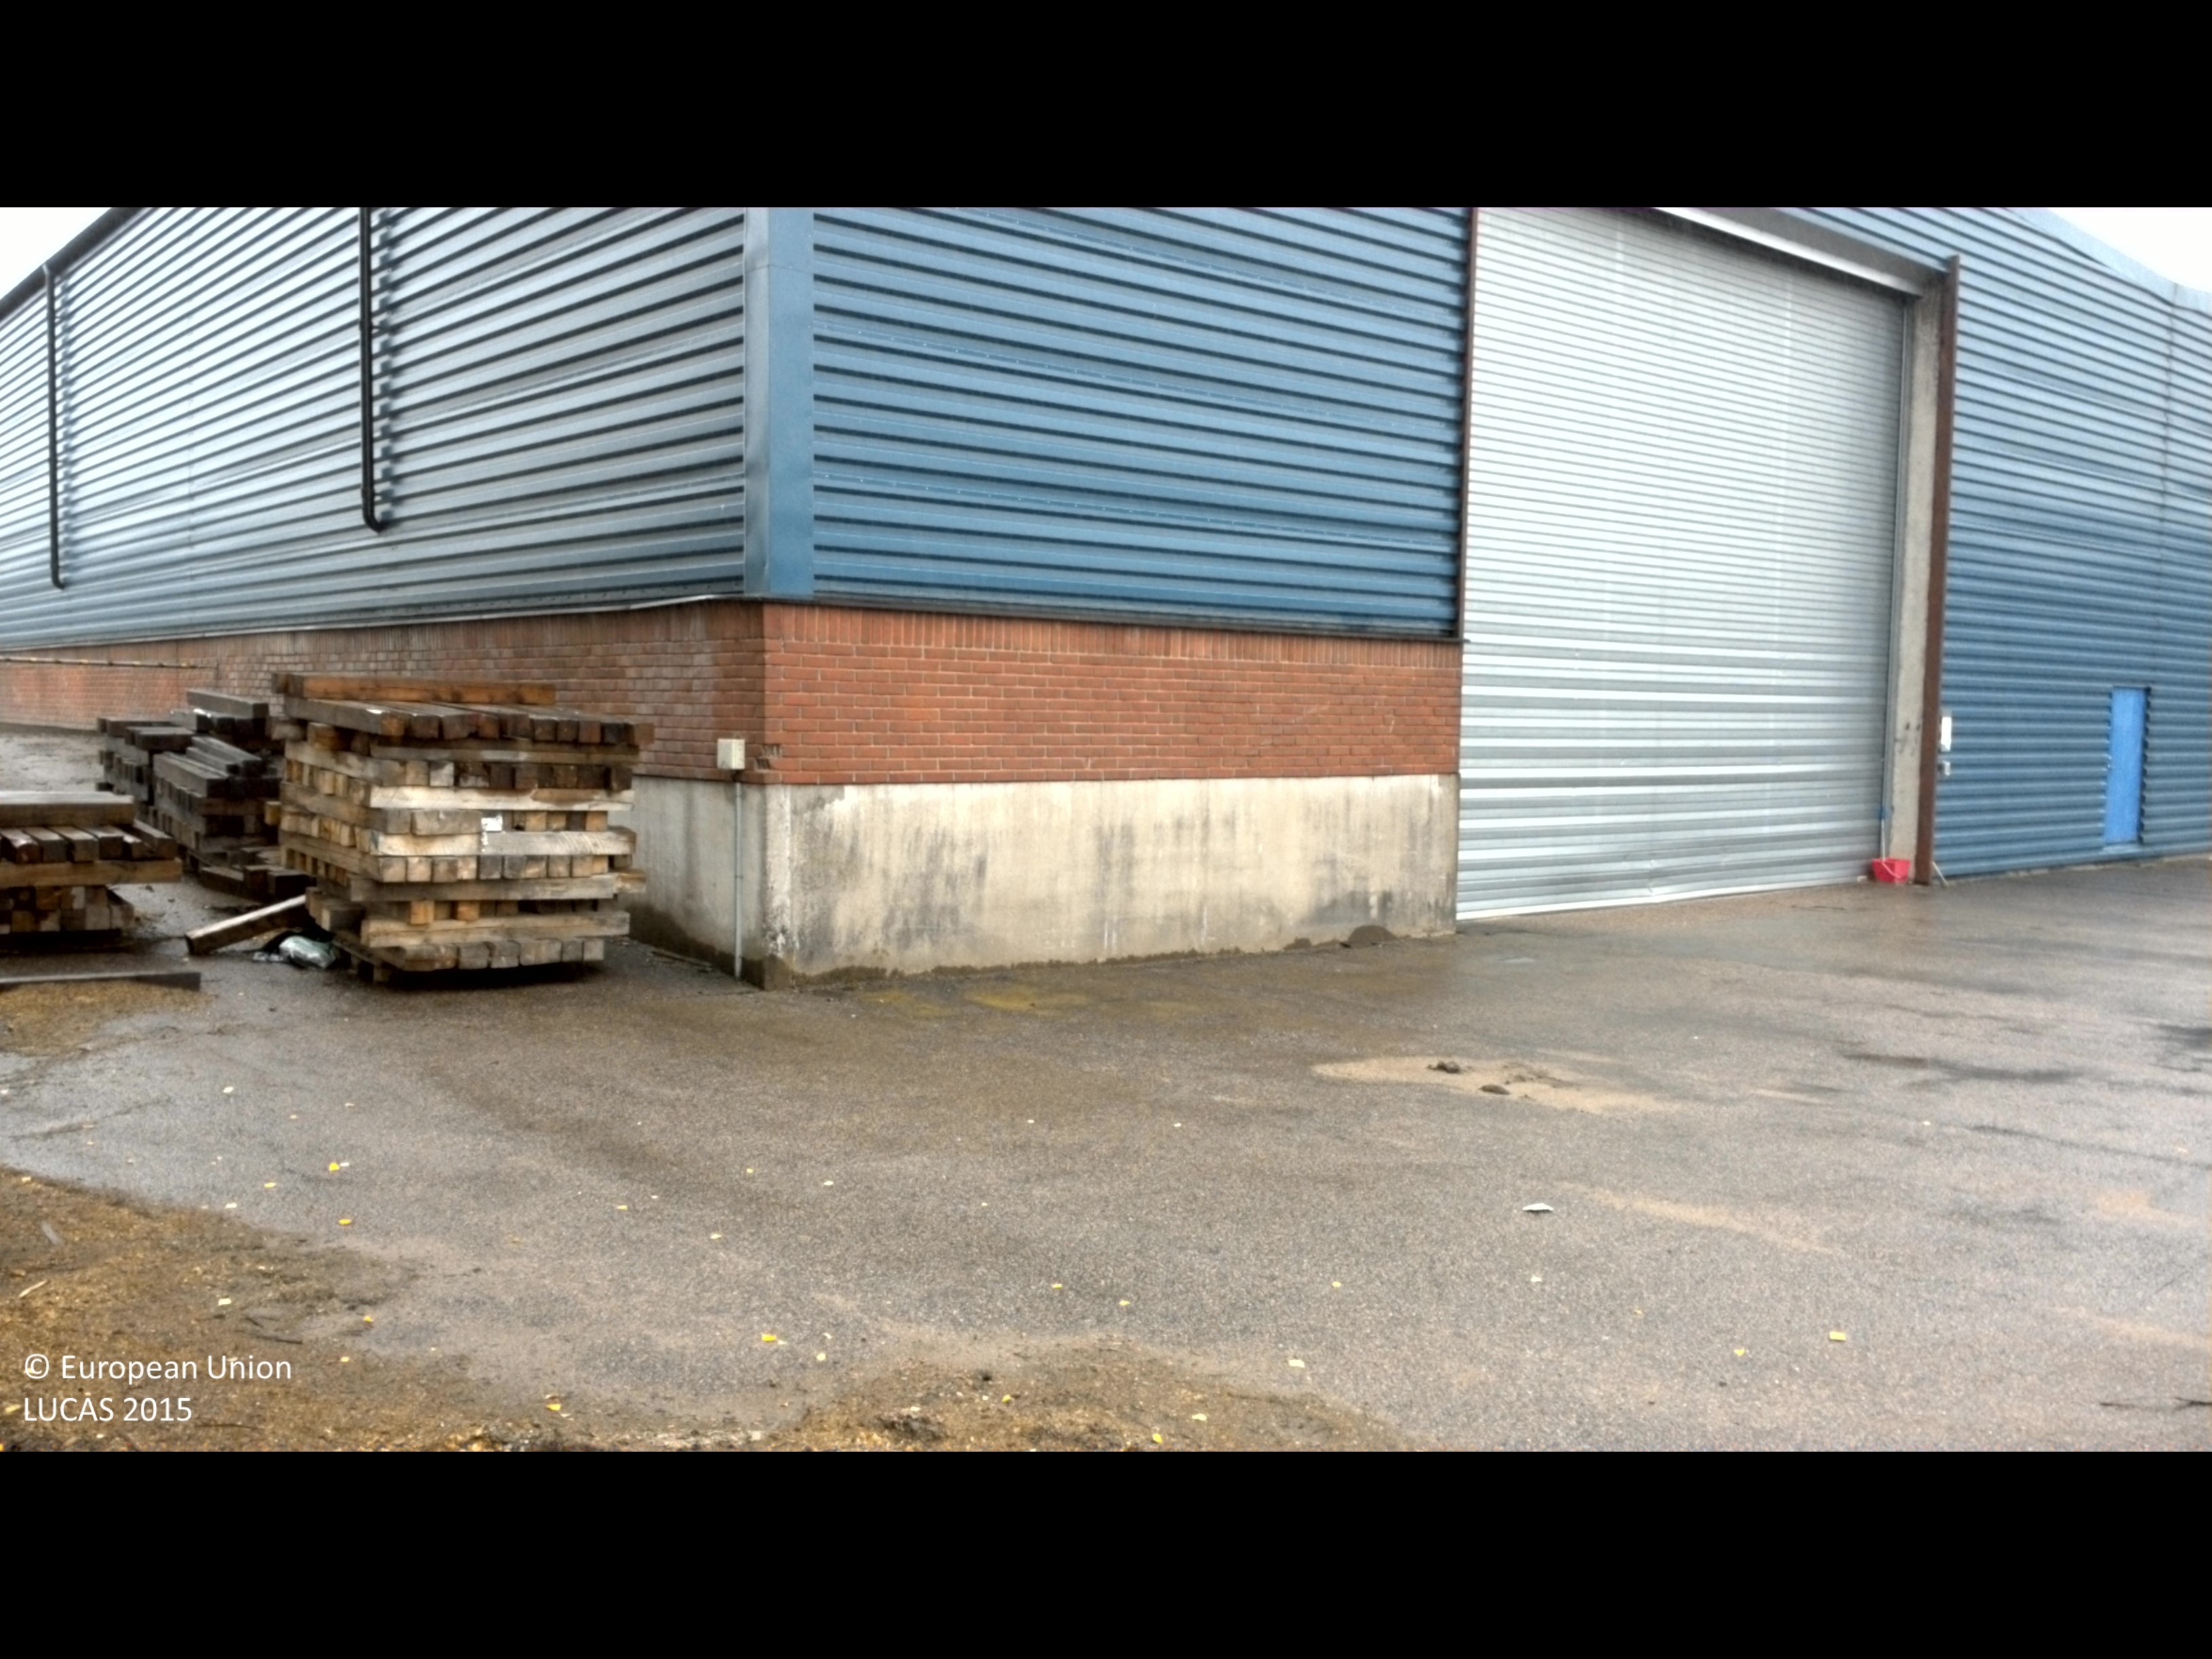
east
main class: Woodland
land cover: Broadleaved woodland
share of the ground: 25 - 50 %
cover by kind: broadleaved forest trees 50 %, herbaceous plants 20 %, lichens and mosses 20 %, unconsolidated bare surface 10 %
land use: Semi-natural and natural areas not in use
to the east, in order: Broadleaved woodland; Artificial constructions in urban areas
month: July
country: SE
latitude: 56.5828
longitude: 13.7578
